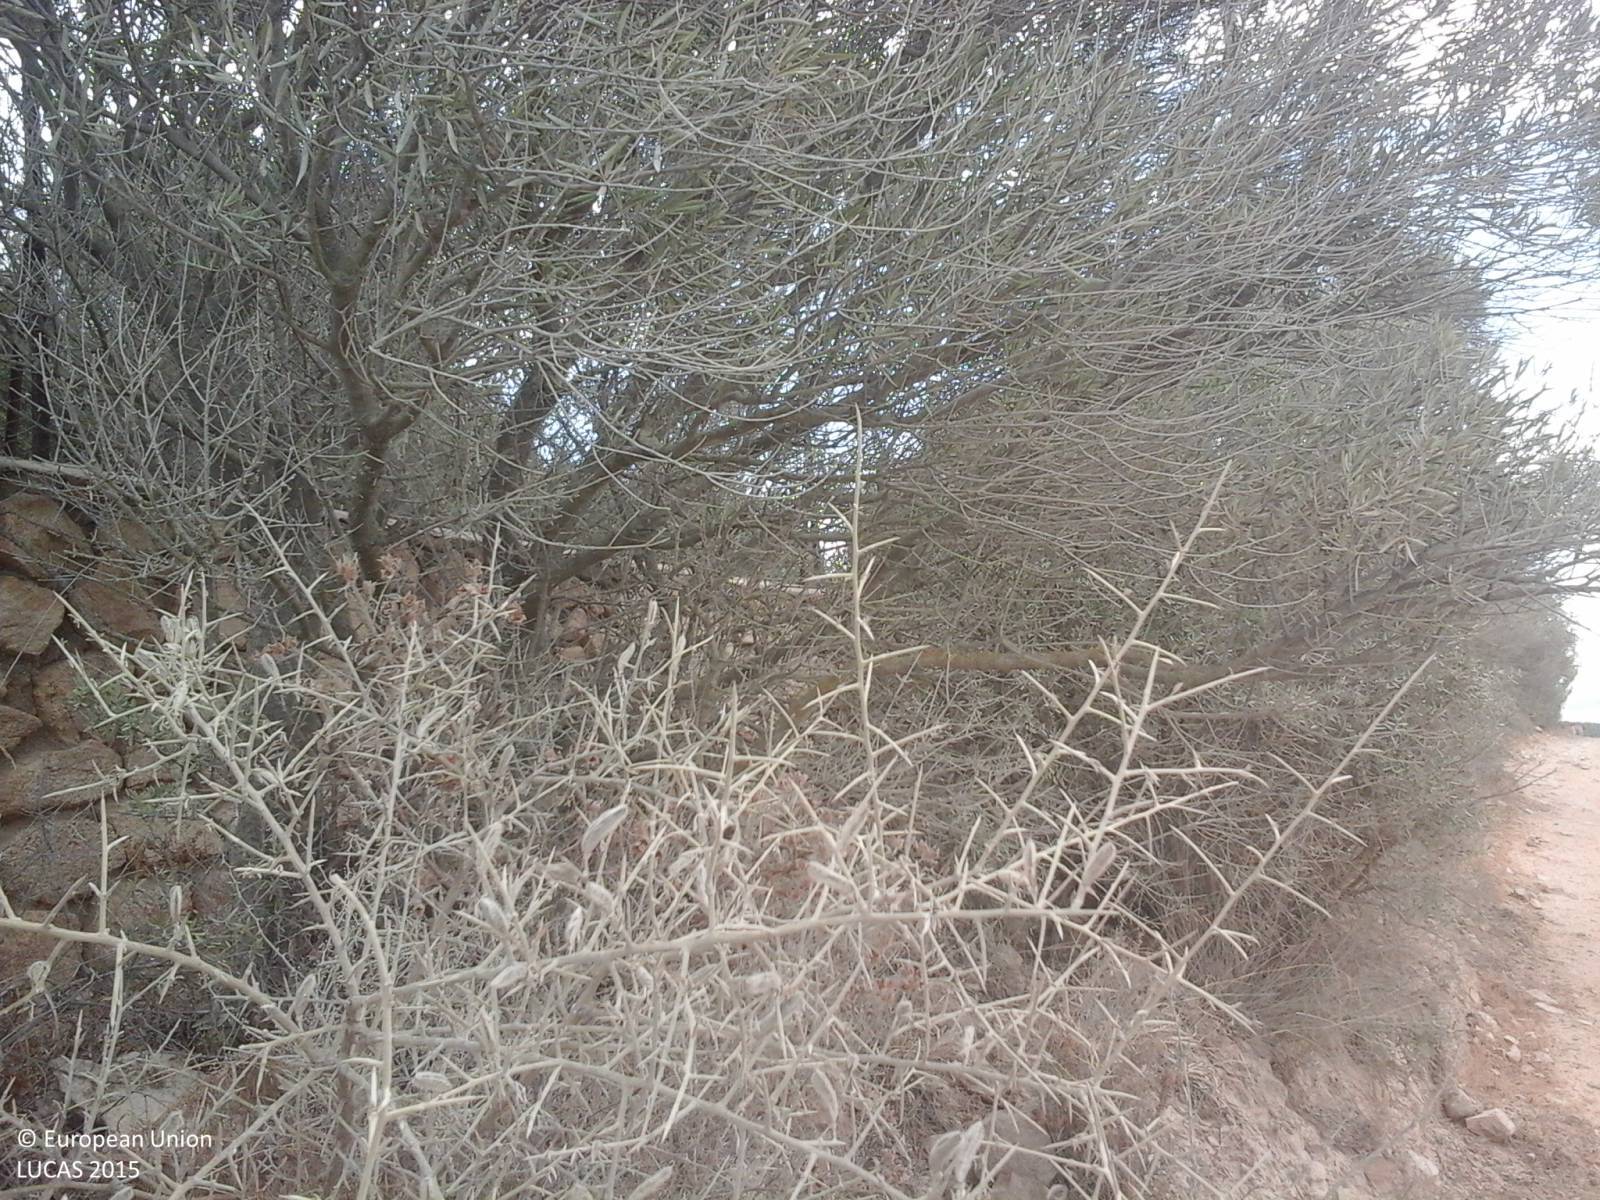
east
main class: Shrubland
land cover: Shrubland with sparse tree cover
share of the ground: > 75 %
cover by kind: shrubs 85 %, unconsolidated bare surface 10 %, broadleaved forest trees 5 %
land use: Semi-natural and natural areas not in use
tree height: > 5 m
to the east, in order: Shrubland with sparse tree cover; Tracks; Shrubland with sparse tree cover
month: August
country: IT
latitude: 40.9905
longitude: 9.6332
